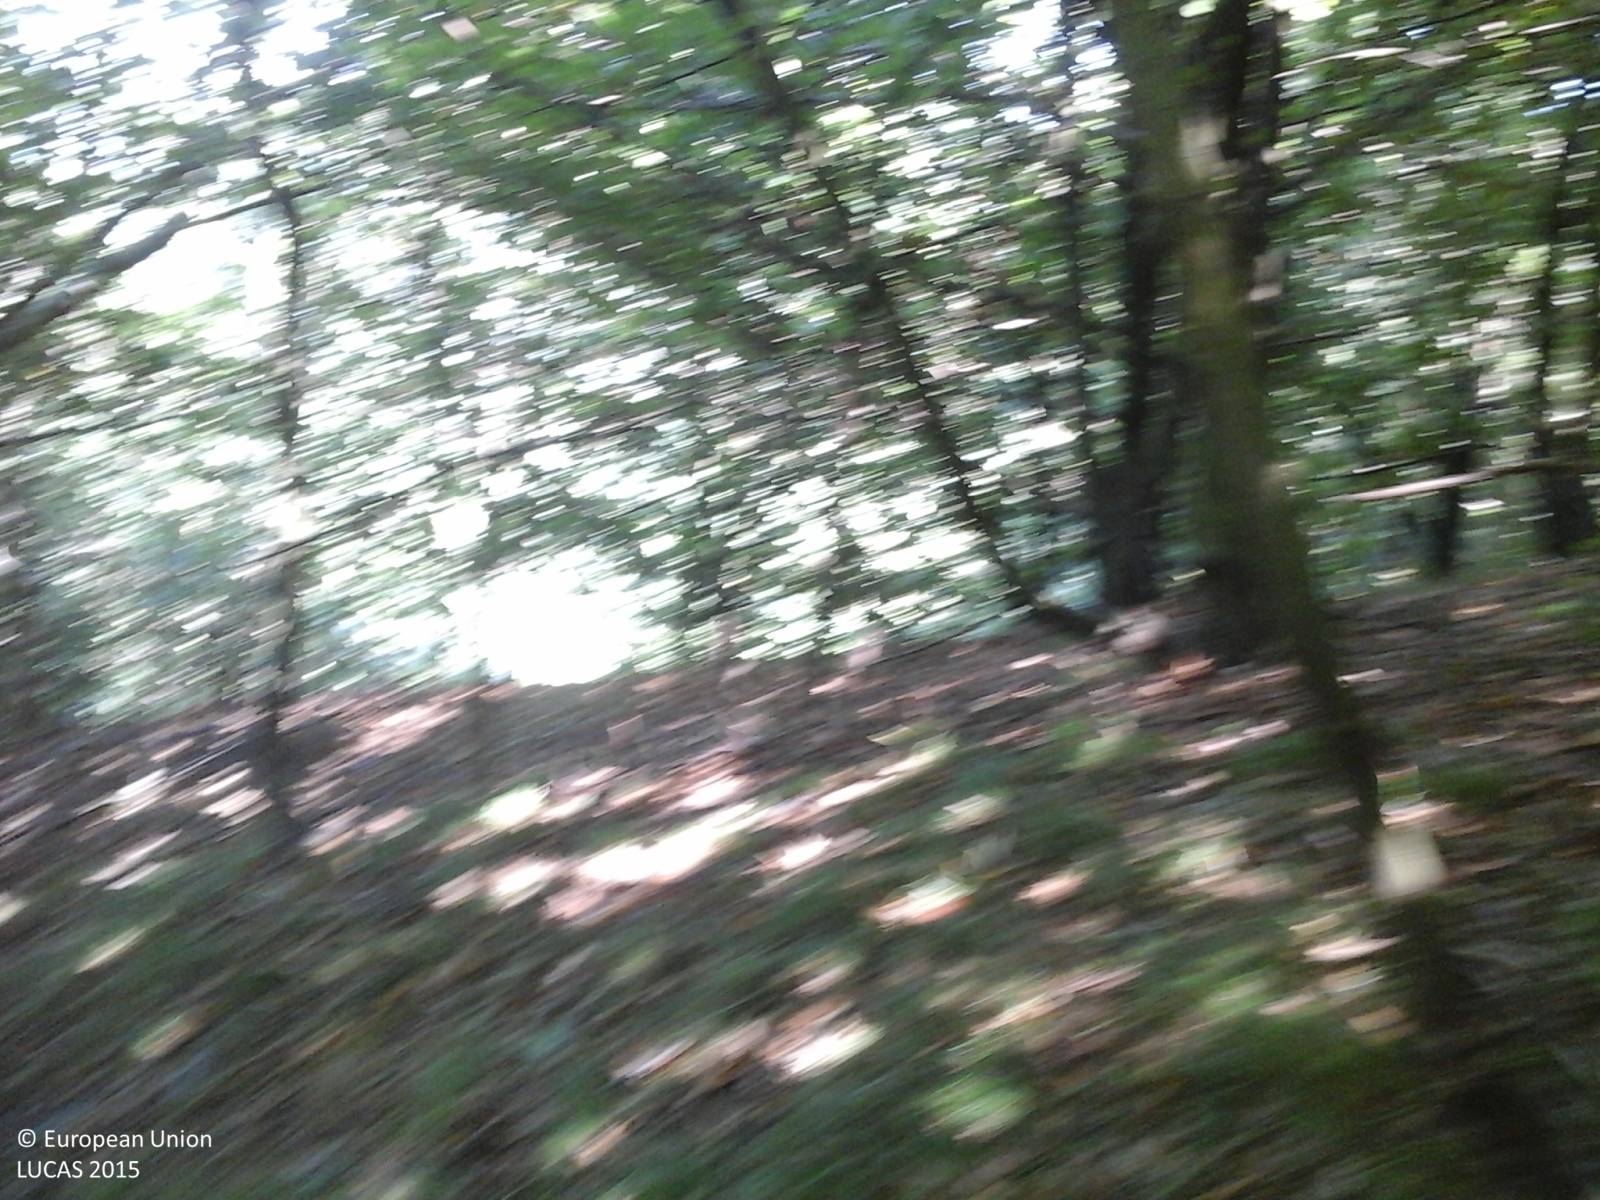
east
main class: Woodland
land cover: Broadleaved woodland
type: thermophilous deciduous forest
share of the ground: > 75 %
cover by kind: broadleaved forest trees 75 %, herbaceous plants 10 %, coniferous forest trees 5 %, shrubs 5 %, lichens and mosses 5 %
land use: Semi-natural and natural areas not in use
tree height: > 5 m
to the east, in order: Broadleaved woodland; Paved roads, cycling and walking lanes; Broadleaved woodland
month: August
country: IT
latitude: 44.4871
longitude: 8.7328
